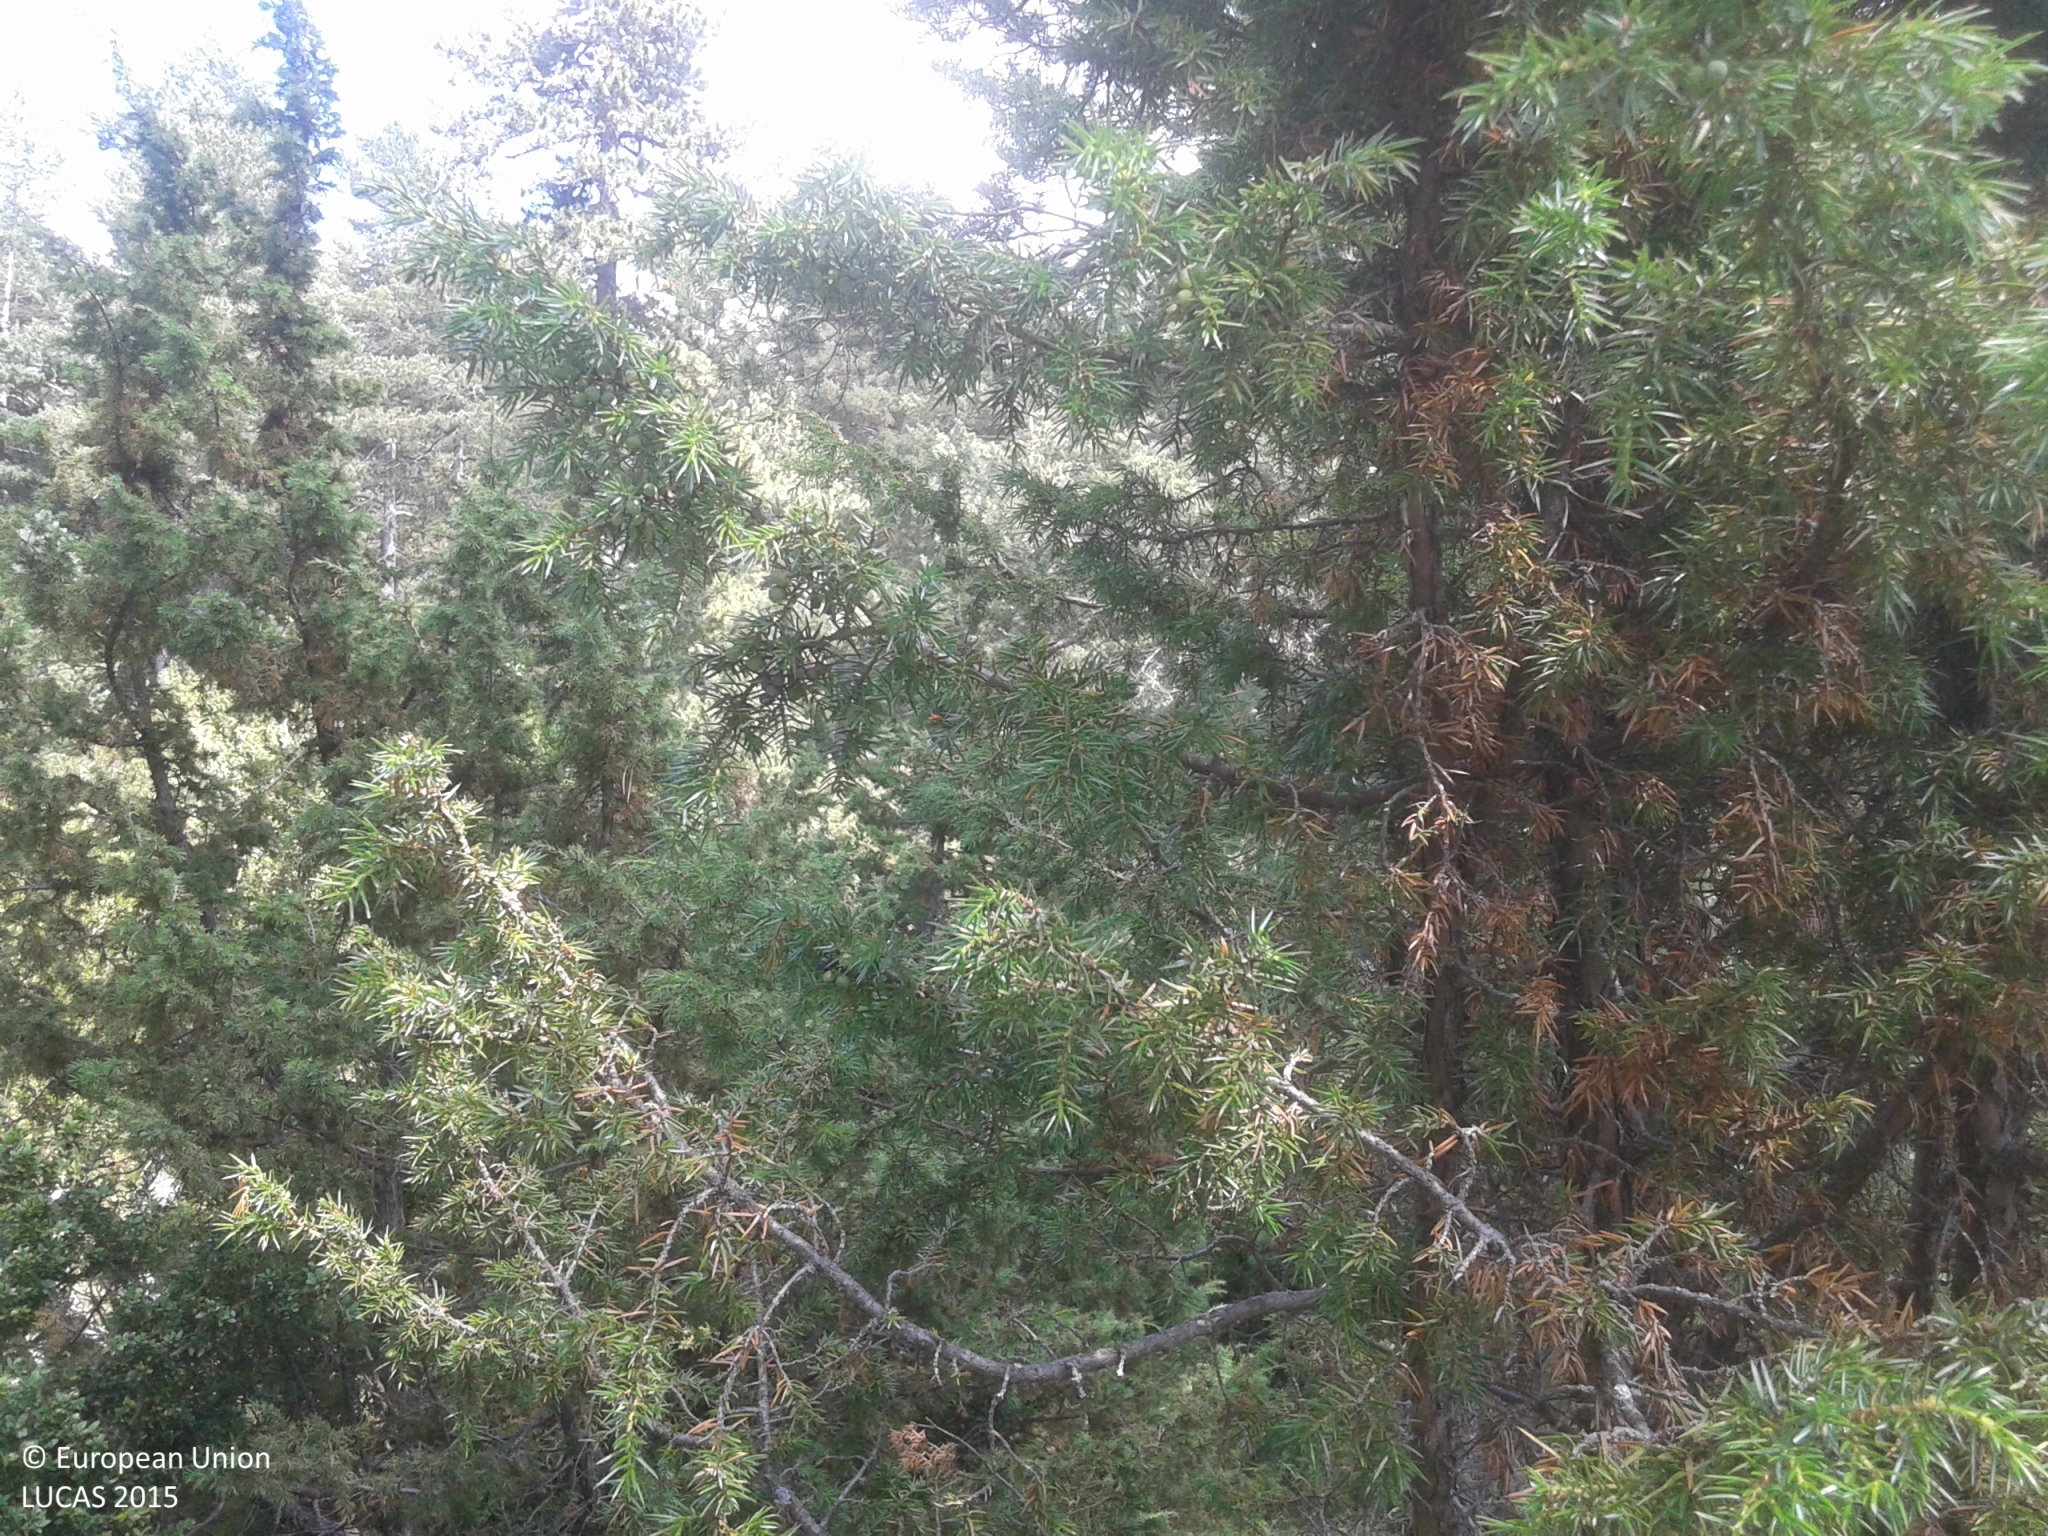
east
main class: Woodland
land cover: Pine dominated coniferous woodland
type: alpine coniferous forest
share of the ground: 25 - 50 %
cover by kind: shrubs 40 %, coniferous forest trees 30 %, herbaceous plants 30 %
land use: Semi-natural and natural areas not in use
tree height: > 5 m
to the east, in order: Pine dominated coniferous woodland
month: July
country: ES
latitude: 42.2312
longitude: 1.5901
